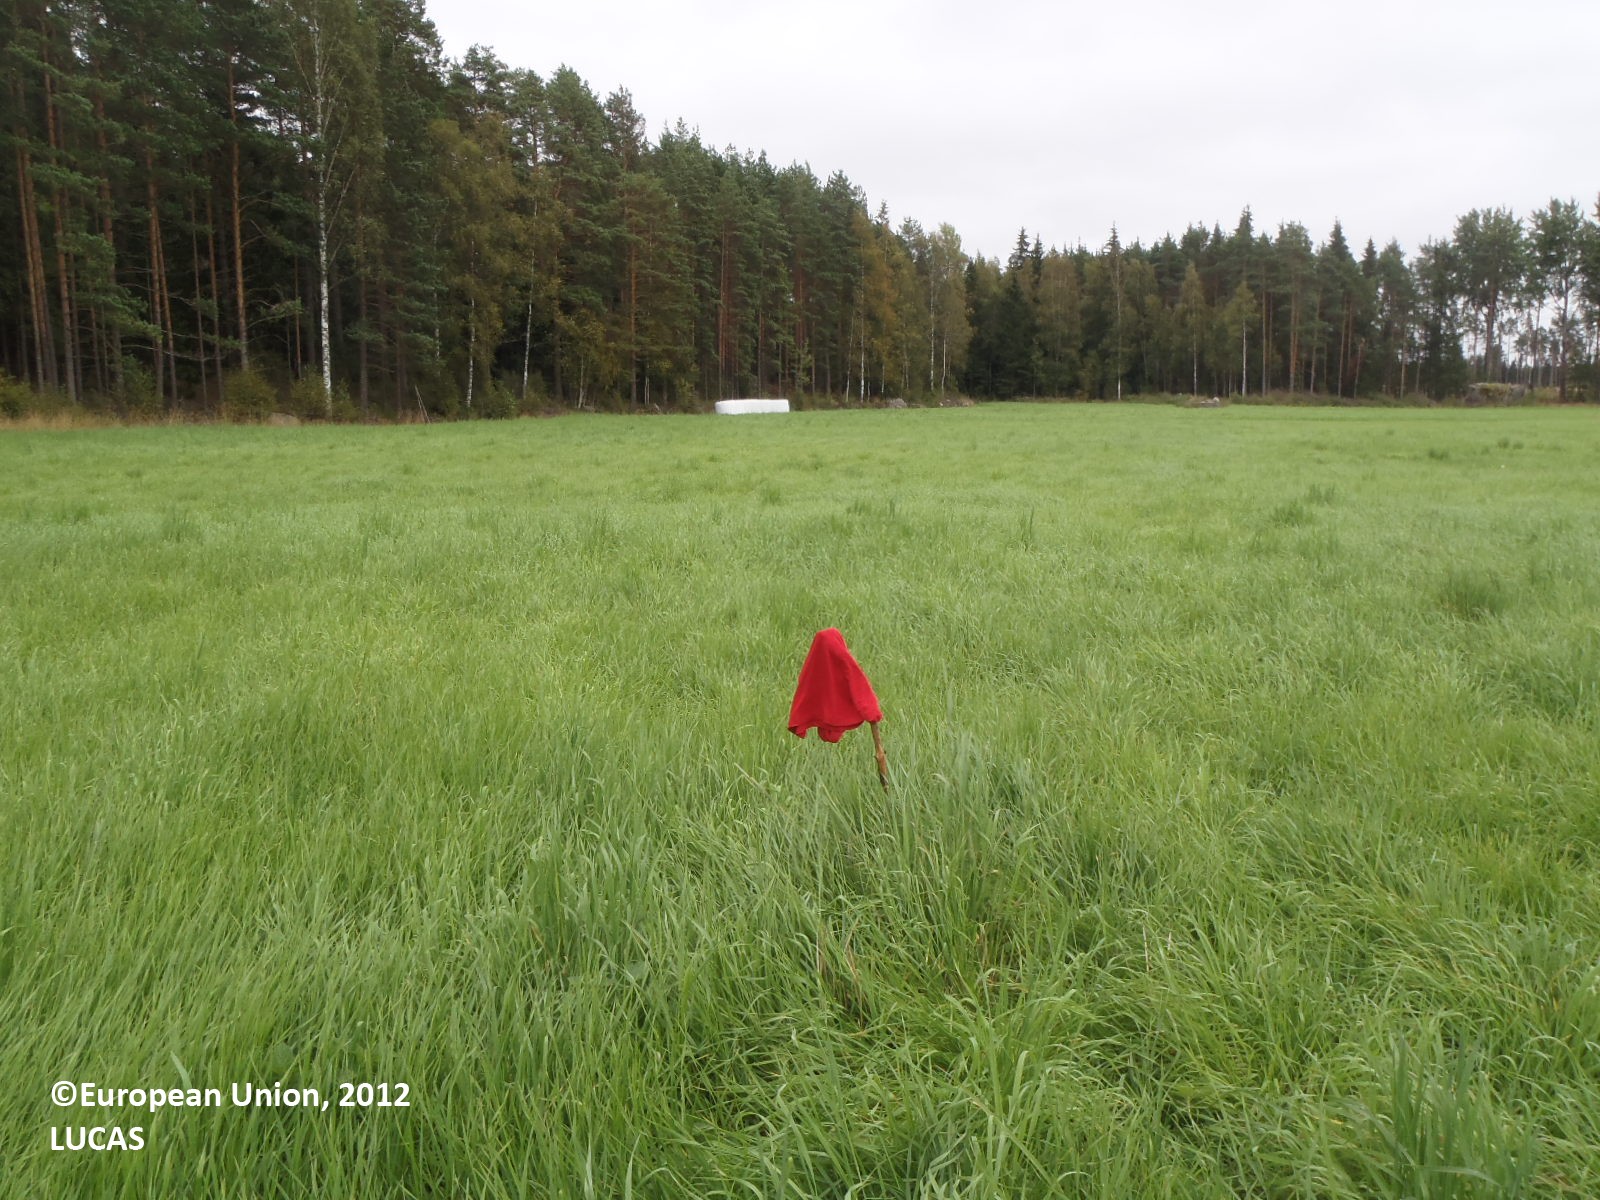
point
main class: Cropland
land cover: Temporary grasslands
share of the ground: > 75 %
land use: Agriculture (excluding fallow land and kitchen gardens)
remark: Harvested field
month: August
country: FI
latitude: 60.8046
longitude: 21.9139
